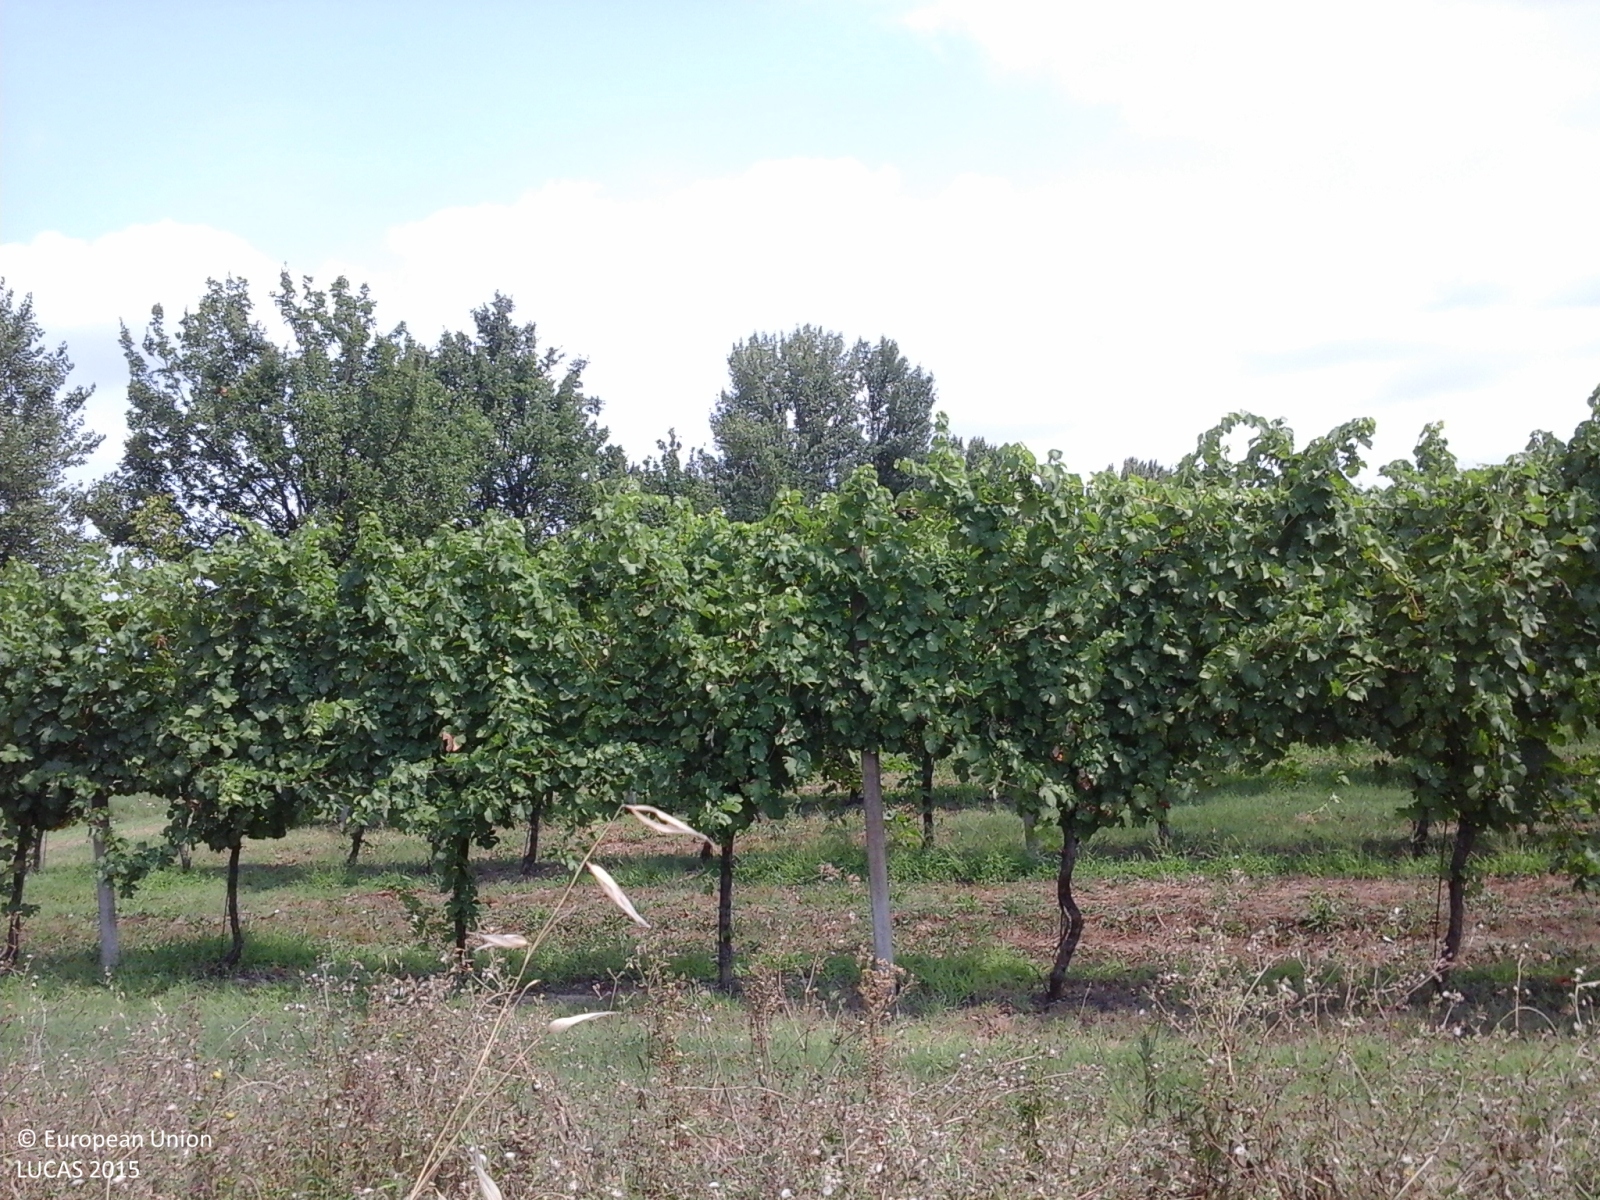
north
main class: Grassland
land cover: Spontaneously vegetated surfaces
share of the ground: > 75 %
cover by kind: herbaceous plants 100 %
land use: Fallow land
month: July
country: IT
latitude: 44.3329
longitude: 11.9146
